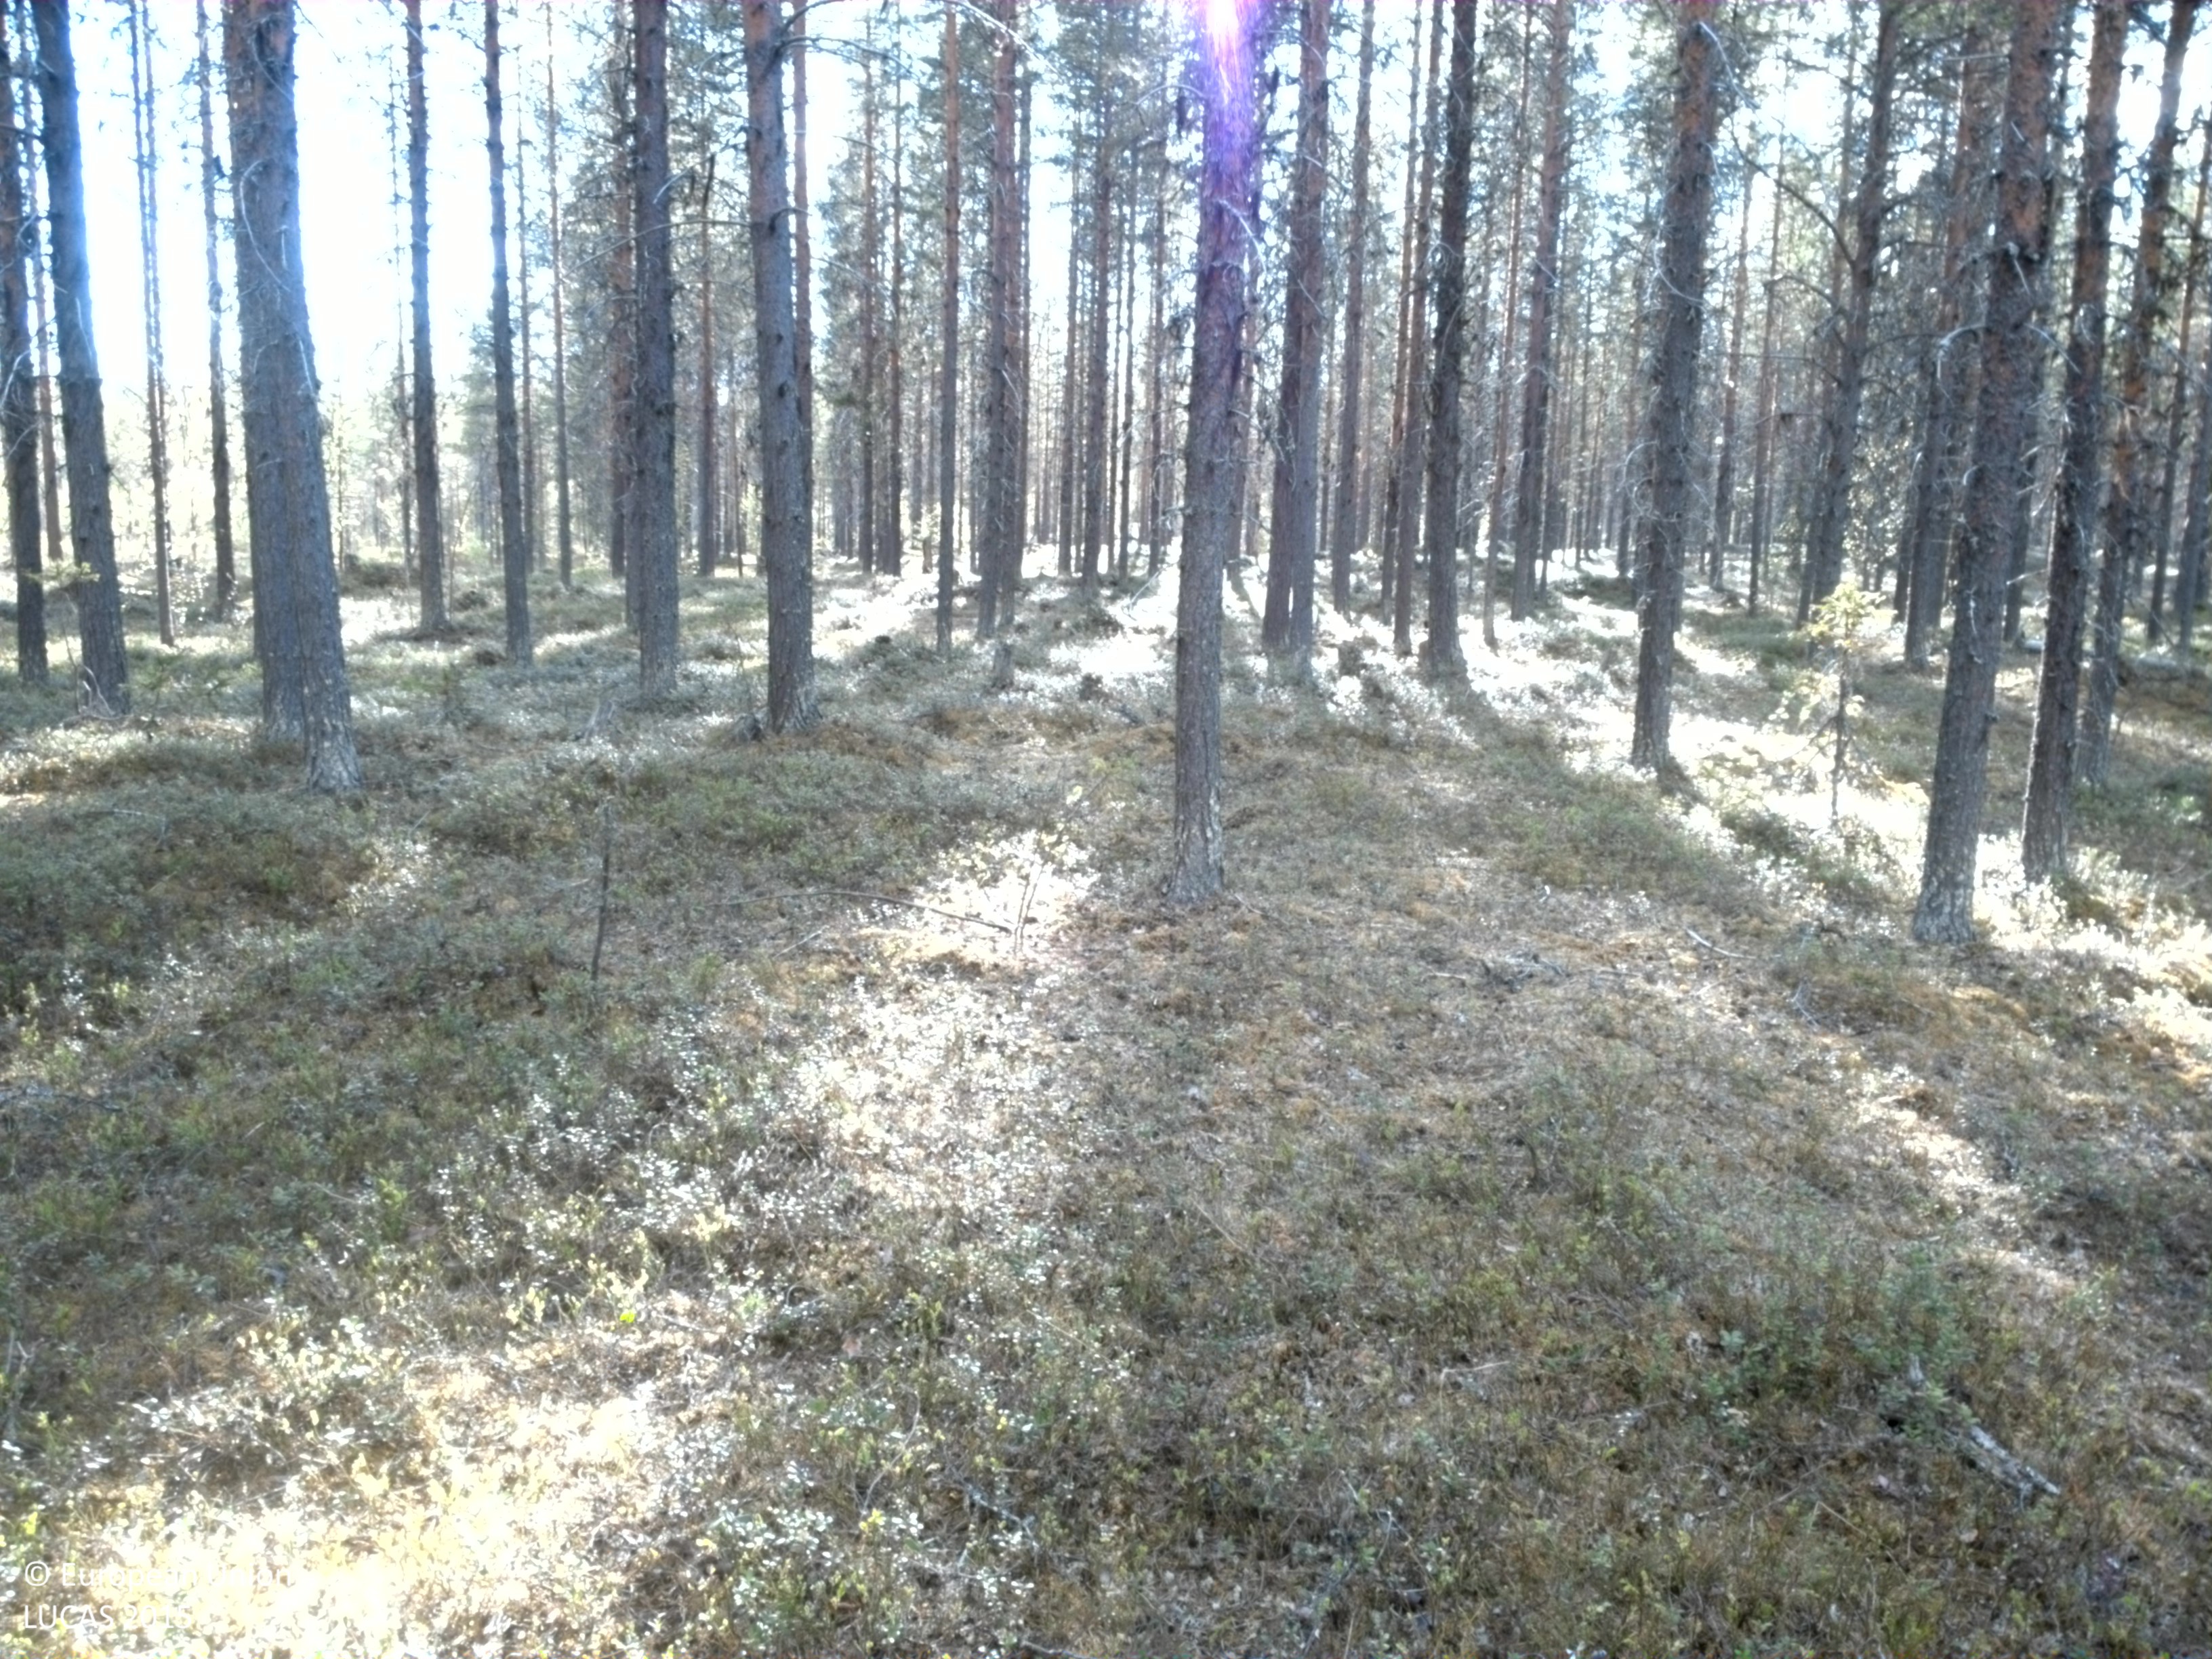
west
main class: Woodland
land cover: Pine dominated coniferous woodland
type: boreal forest
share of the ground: 25 - 50 %
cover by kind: shrubs 55 %, coniferous forest trees 40 %, broadleaved forest trees 5 %
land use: Forestry
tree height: > 5 m
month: June
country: SE
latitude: 65.8631
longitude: 19.4923
